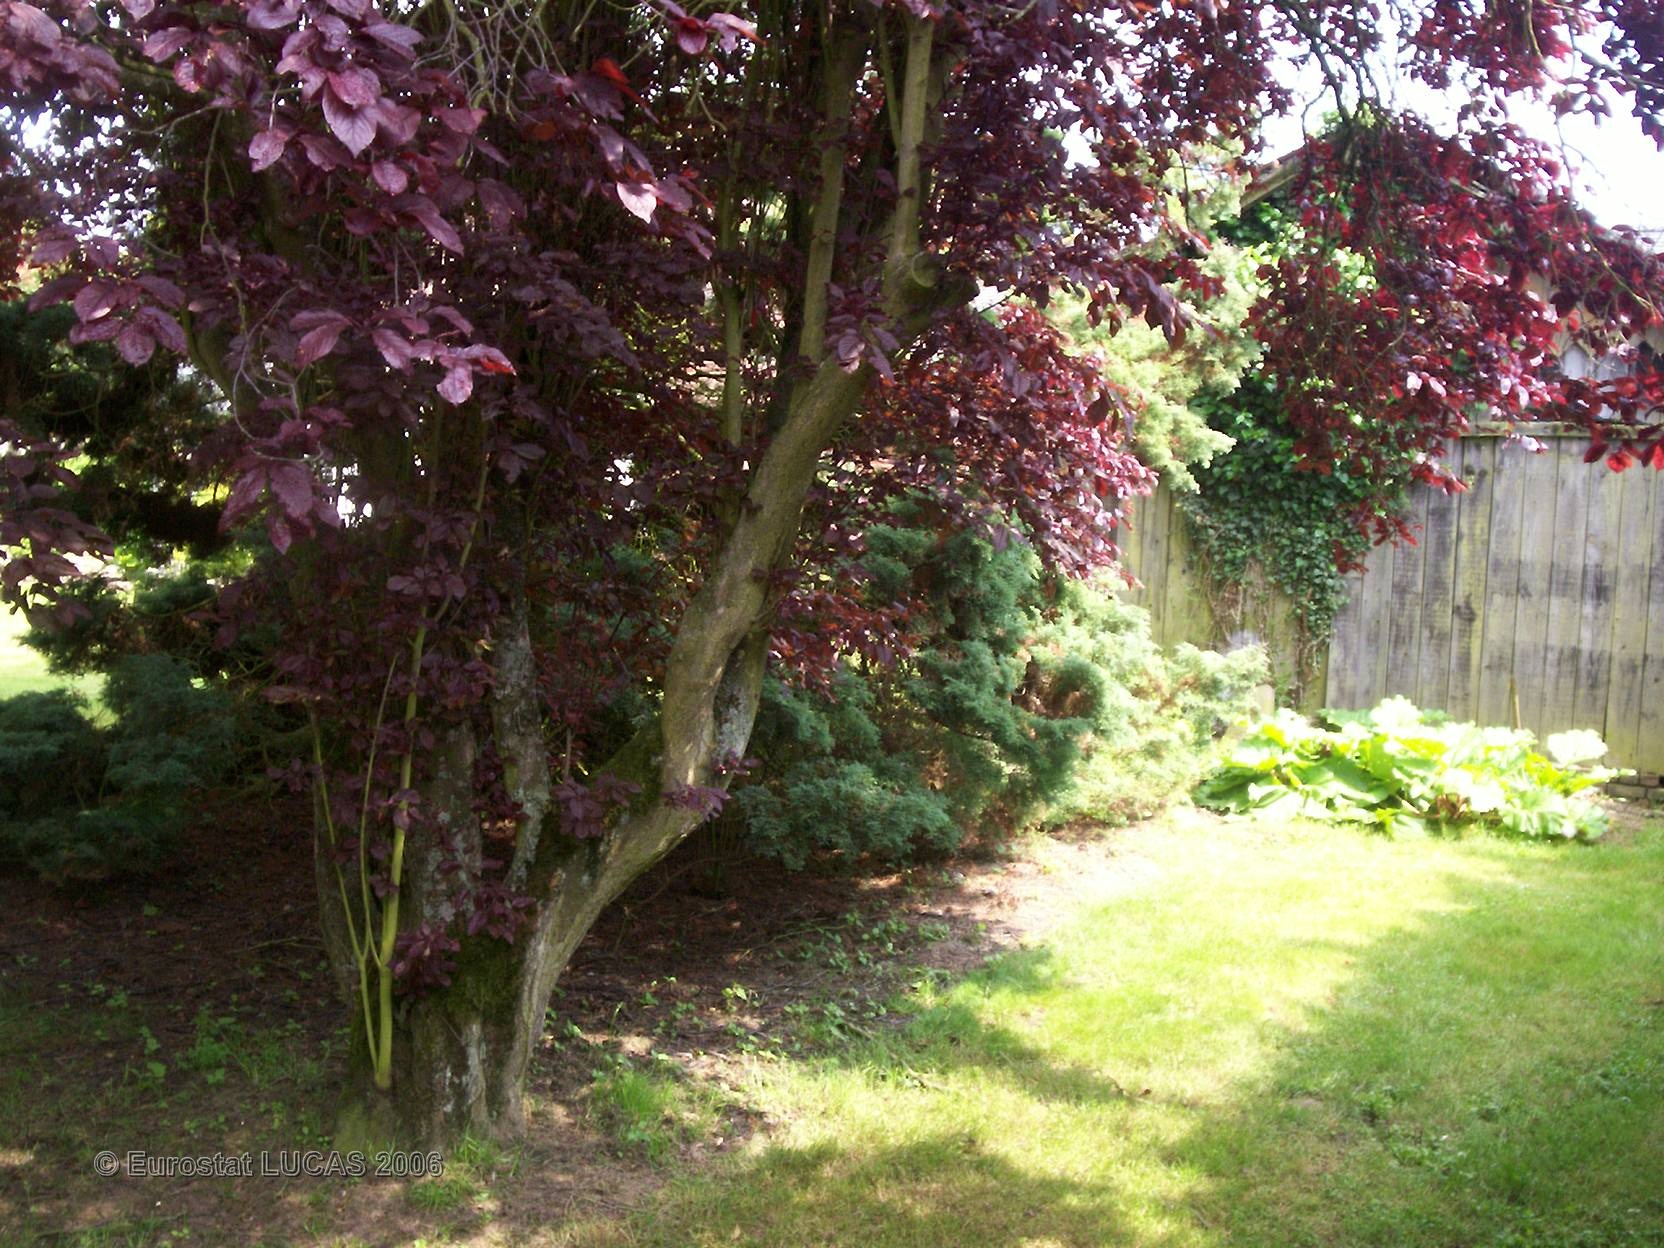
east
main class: Grassland
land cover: Grassland with sparse tree/shrub cover
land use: Residential
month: June
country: FR
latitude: 49.7498
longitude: 2.6745
